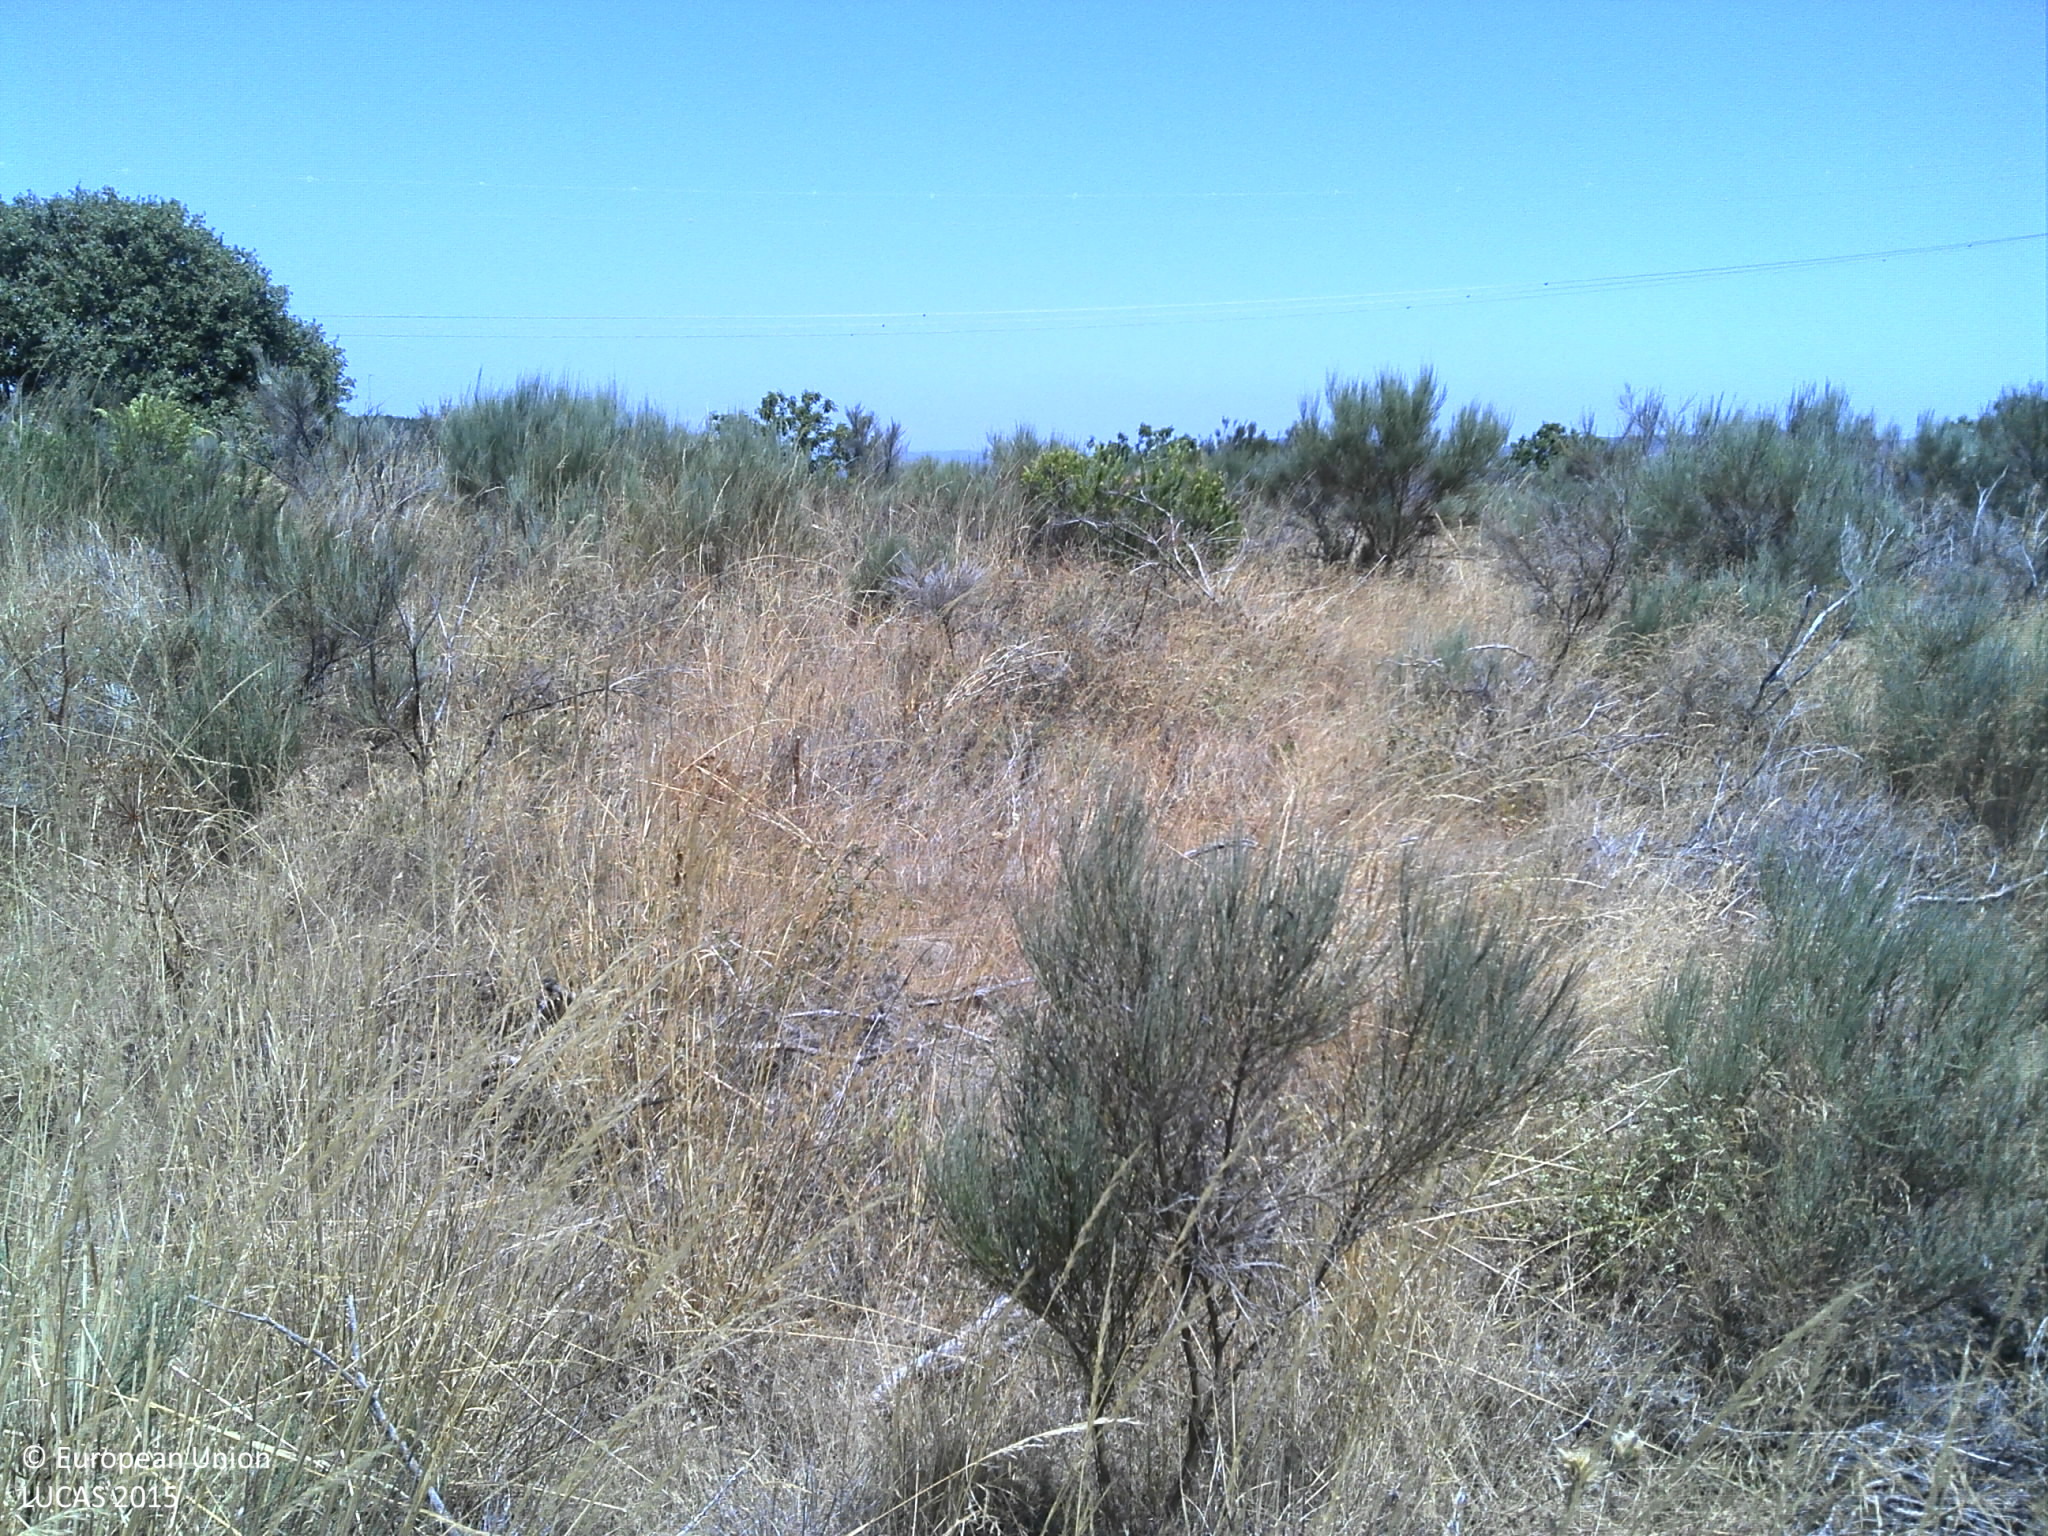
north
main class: Shrubland
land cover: Shrubland without tree cover
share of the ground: 50 - 75 %
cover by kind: shrubs 65 %, herbaceous plants 35 %
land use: Semi-natural and natural areas not in use
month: July
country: PT
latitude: 41.1035
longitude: -7.4688
